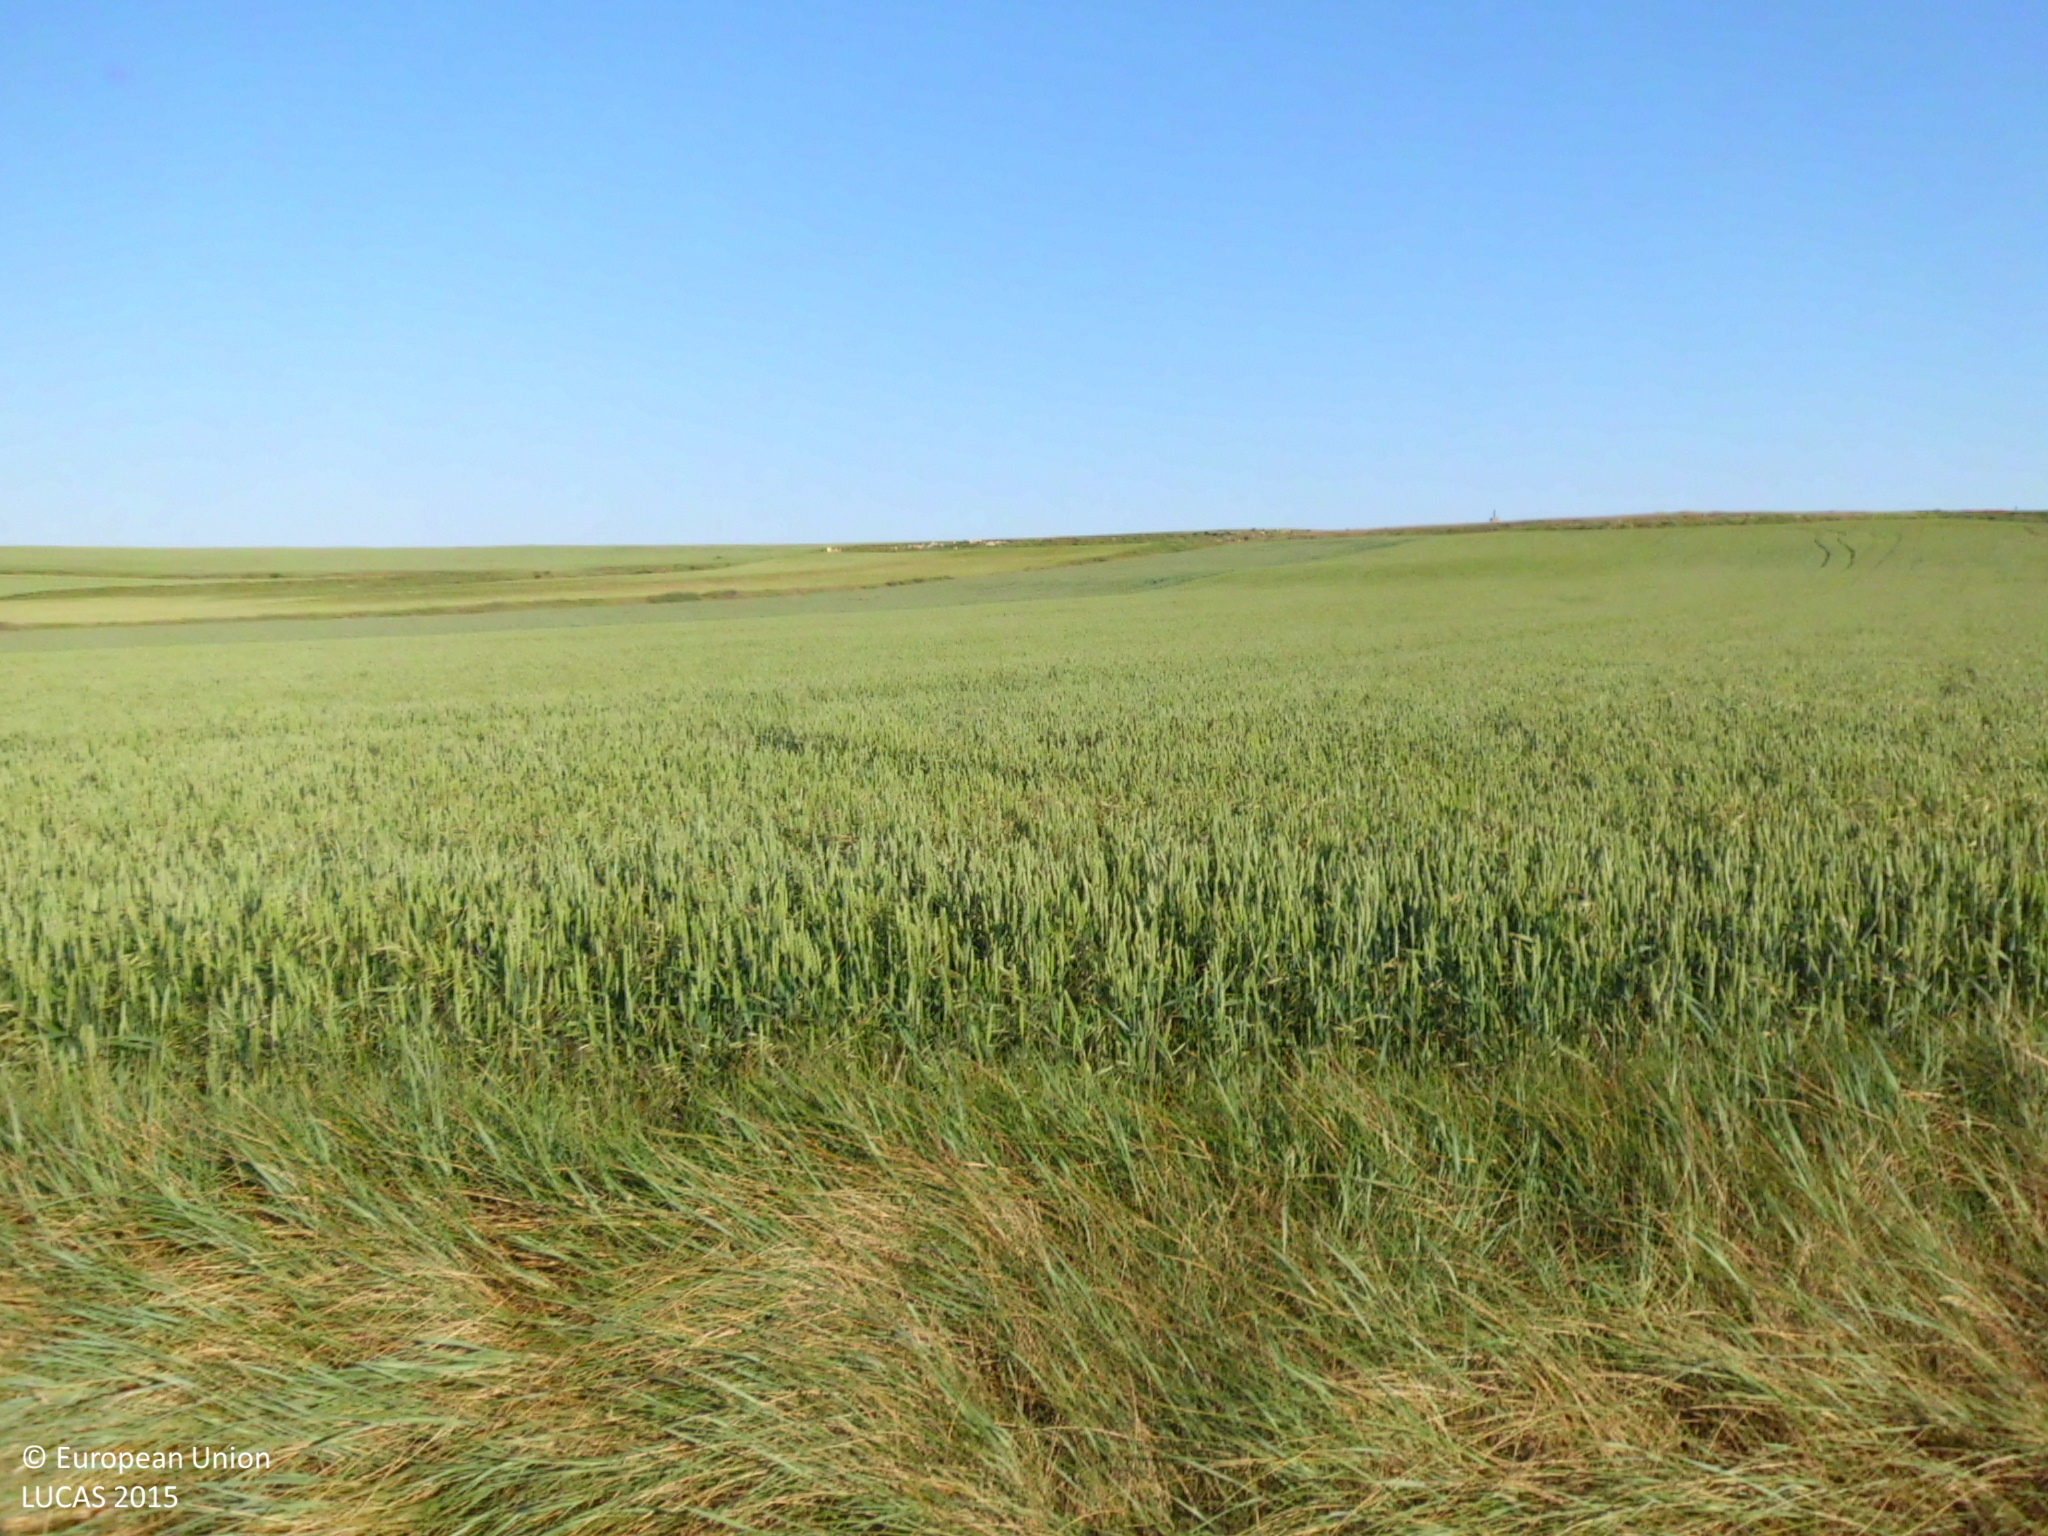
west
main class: Cropland
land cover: Common wheat
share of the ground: > 75 %
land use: Agriculture (excluding fallow land and kitchen gardens)
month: June
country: ES
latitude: 42.3548
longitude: -3.9903
